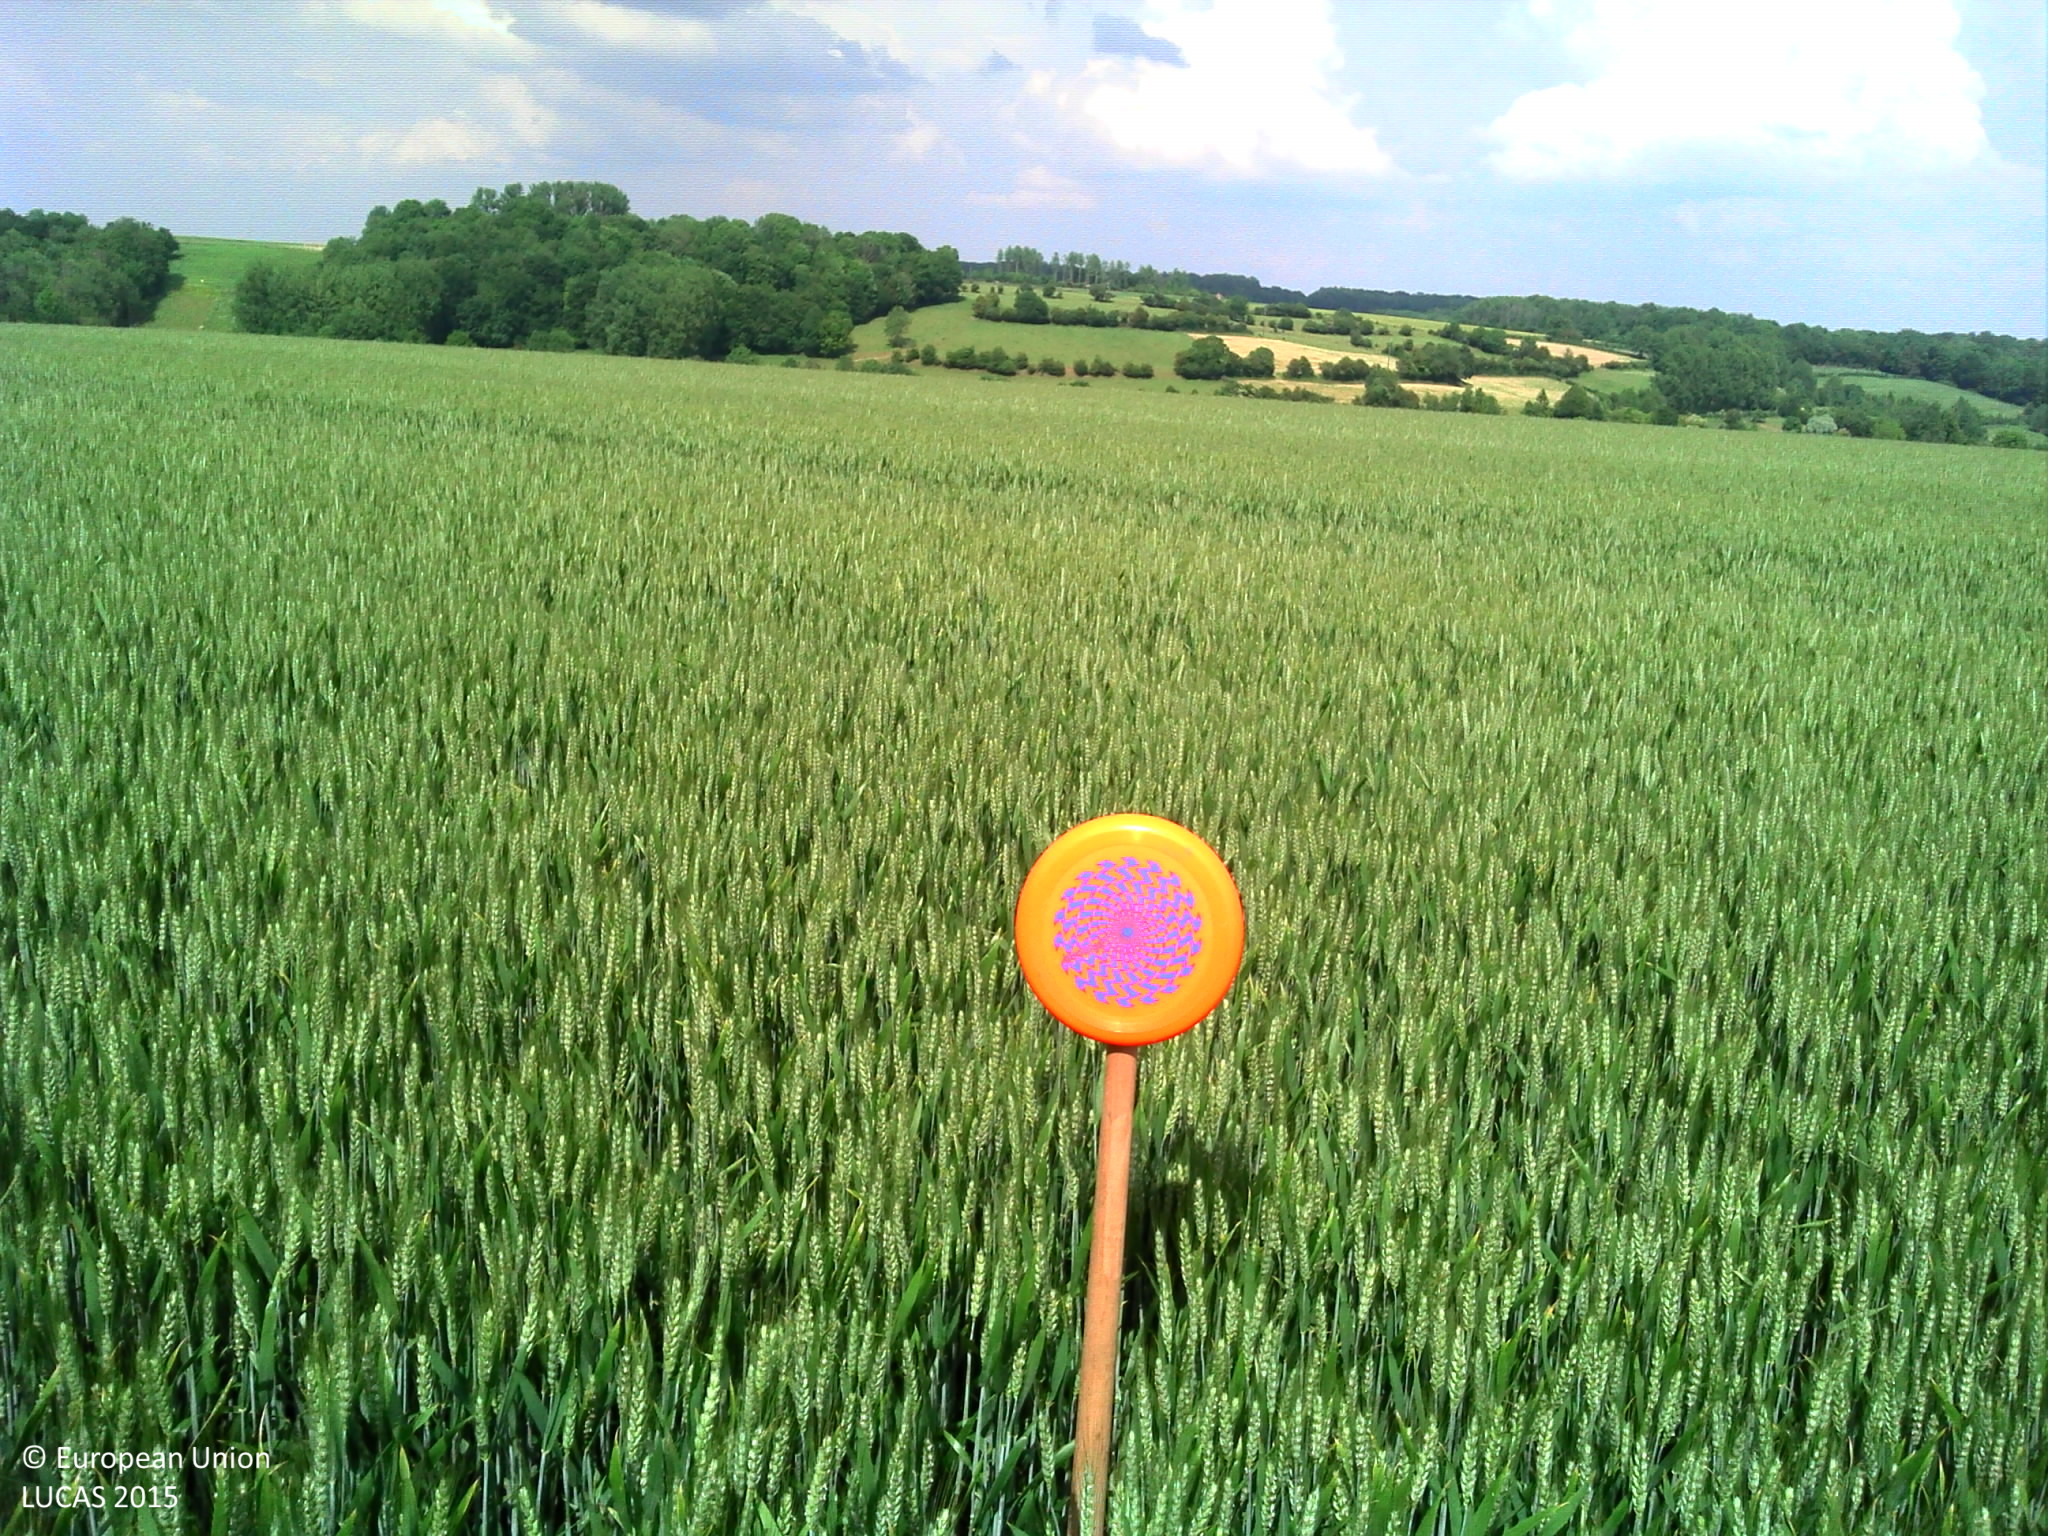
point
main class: Cropland
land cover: Common wheat
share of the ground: > 75 %
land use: Agriculture (excluding fallow land and kitchen gardens)
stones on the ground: 10 - 25 %
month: June
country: FR
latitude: 50.4877
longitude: 2.3613
